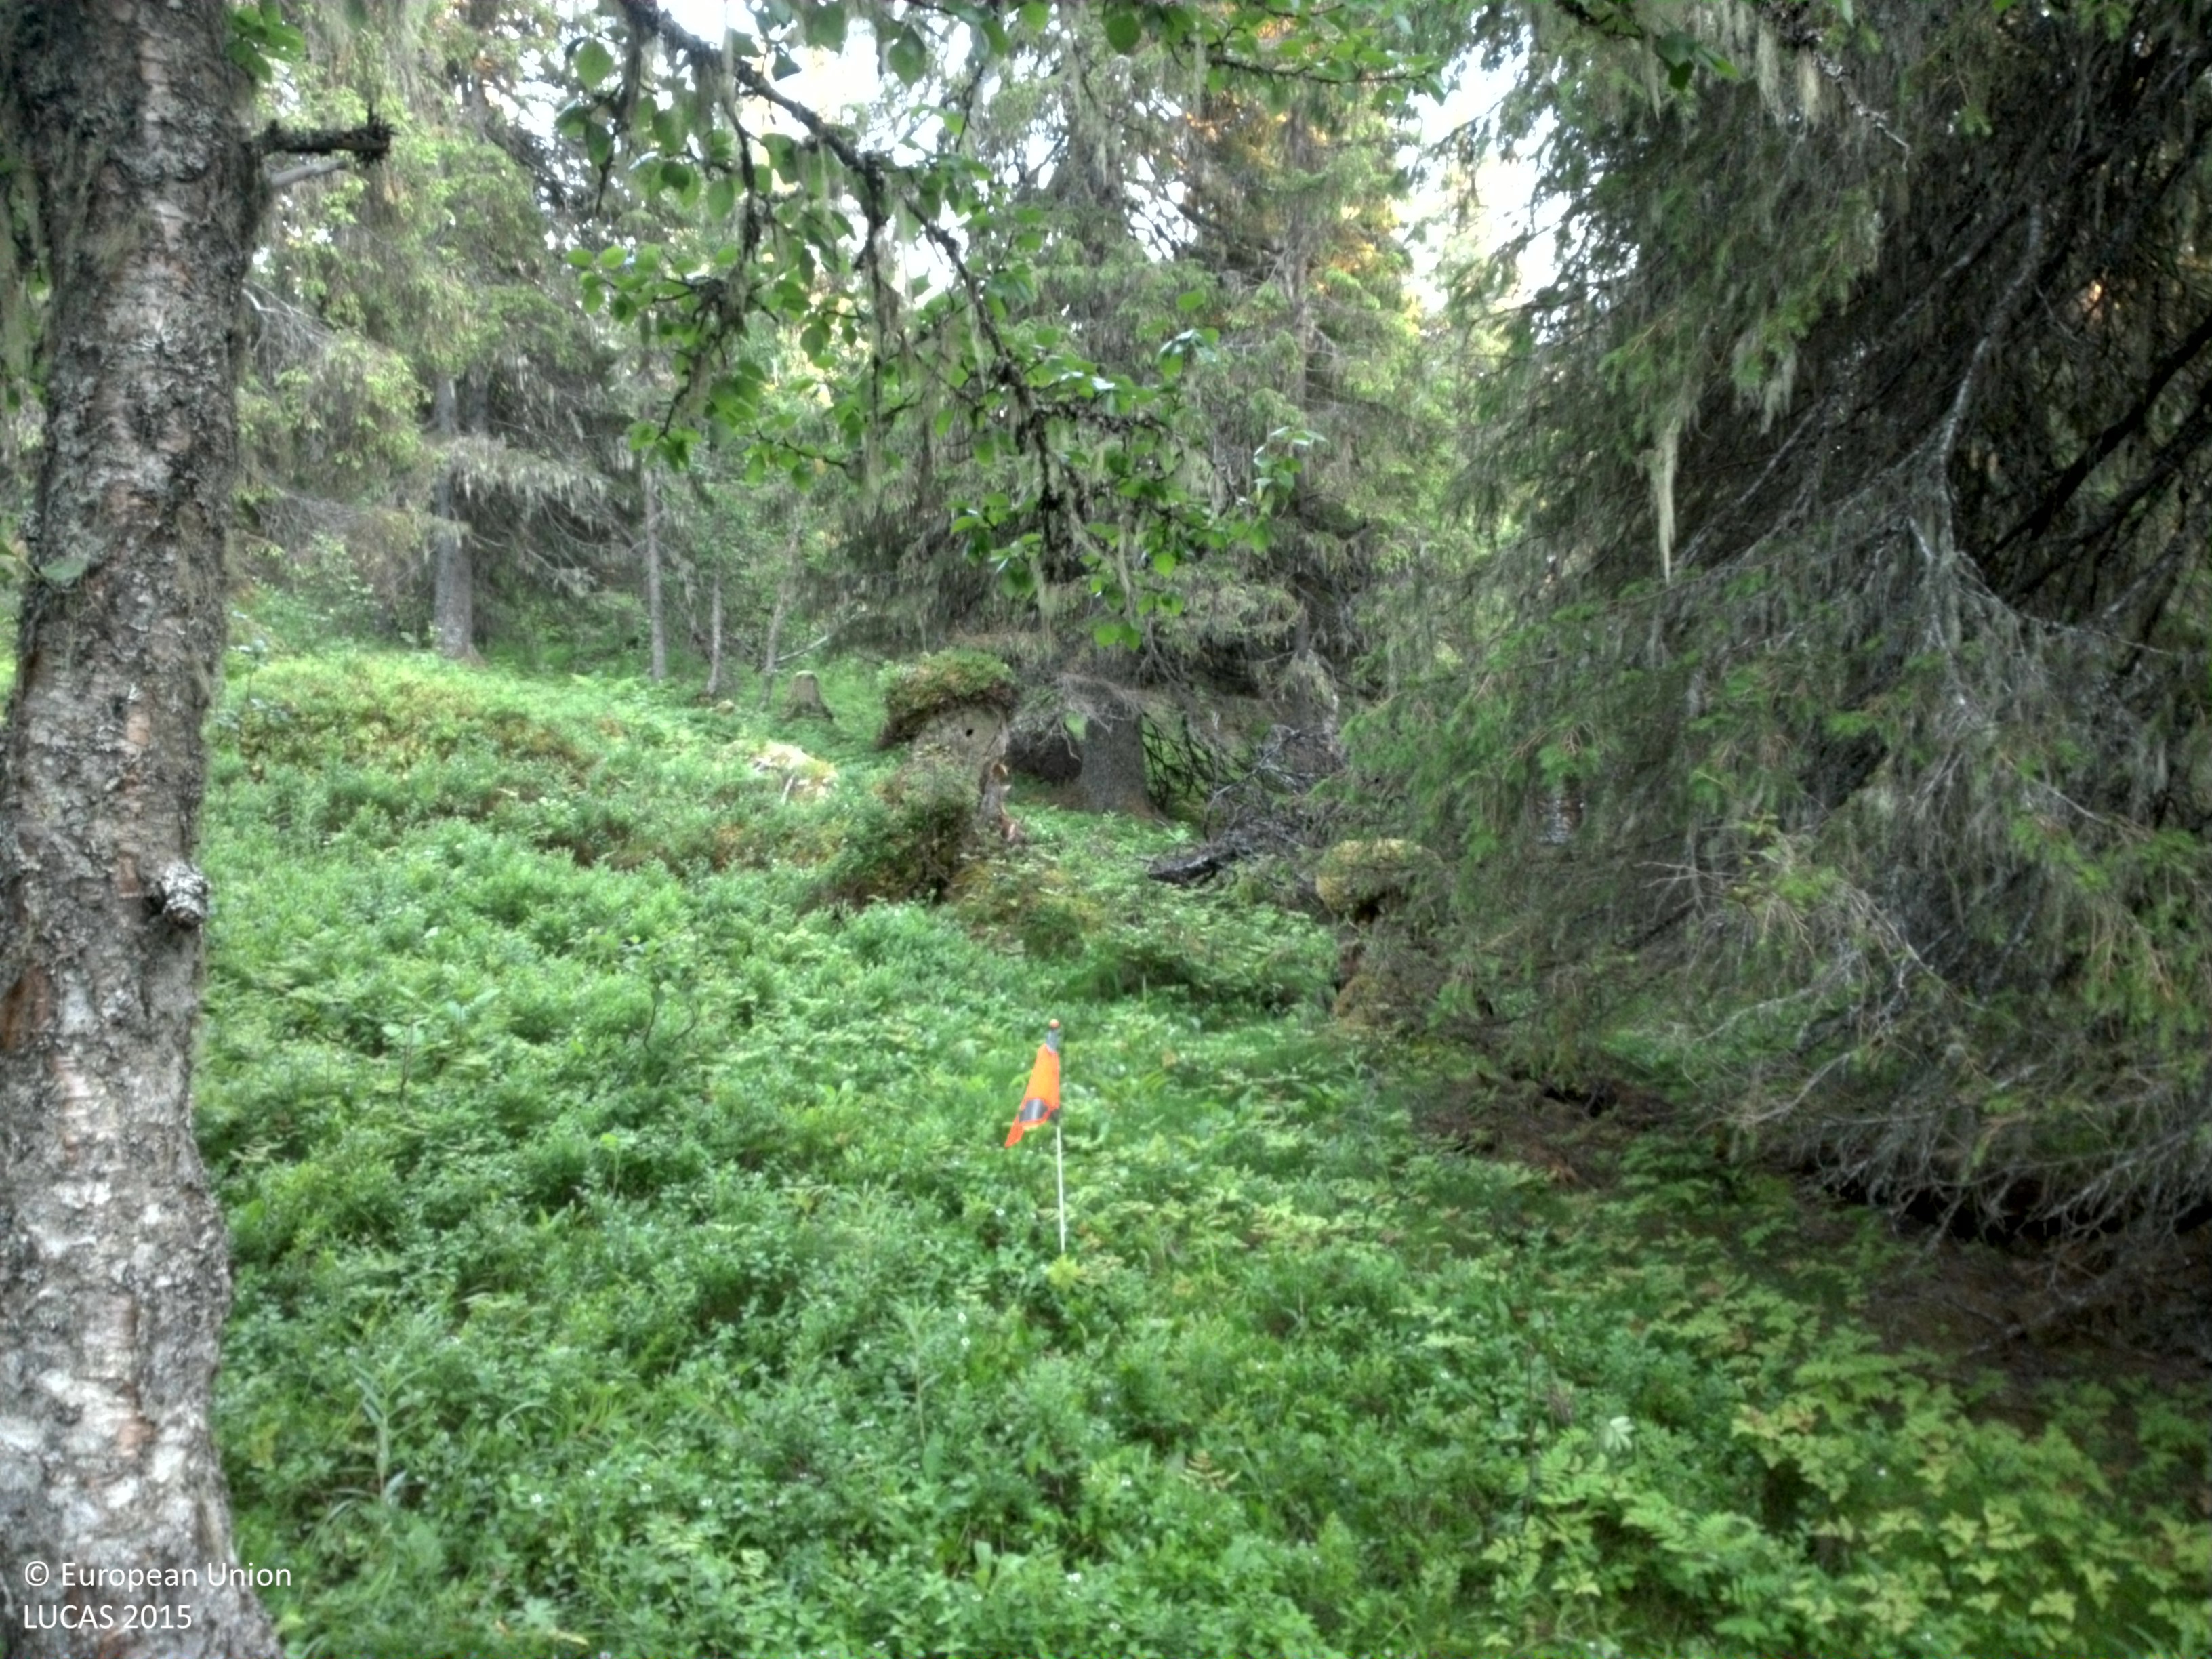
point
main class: Woodland
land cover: Spruce dominated coniferous woodland
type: boreal forest
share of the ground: 25 - 50 %
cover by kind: coniferous forest trees 40 %, herbaceous plants 30 %, shrubs 25 %, lichens and mosses 5 %
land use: Forestry
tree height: > 5 m
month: August
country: SE
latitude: 64.9746
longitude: 15.9619
